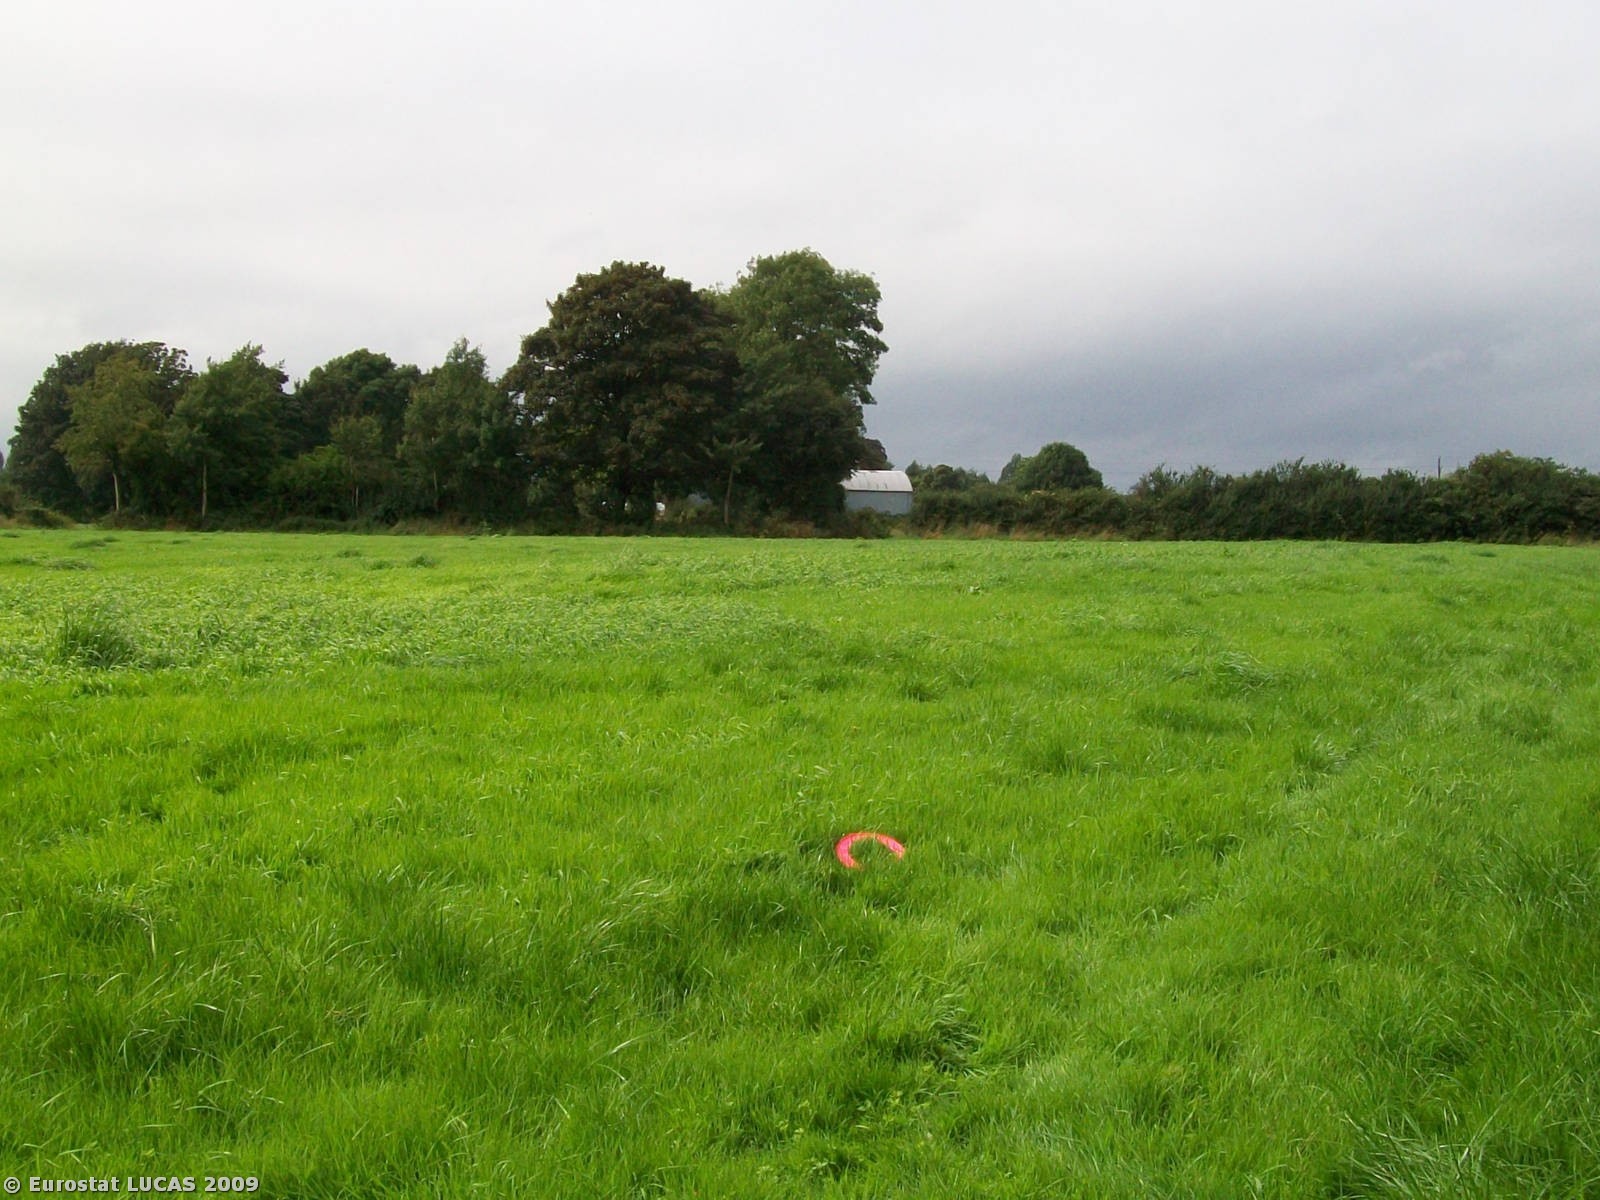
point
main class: Grassland
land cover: Grassland without tree/shrub cover
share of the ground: > 75 %
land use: Agriculture (excluding fallow land and kitchen gardens)
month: August
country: GB
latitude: 54.4867
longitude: -6.0574
